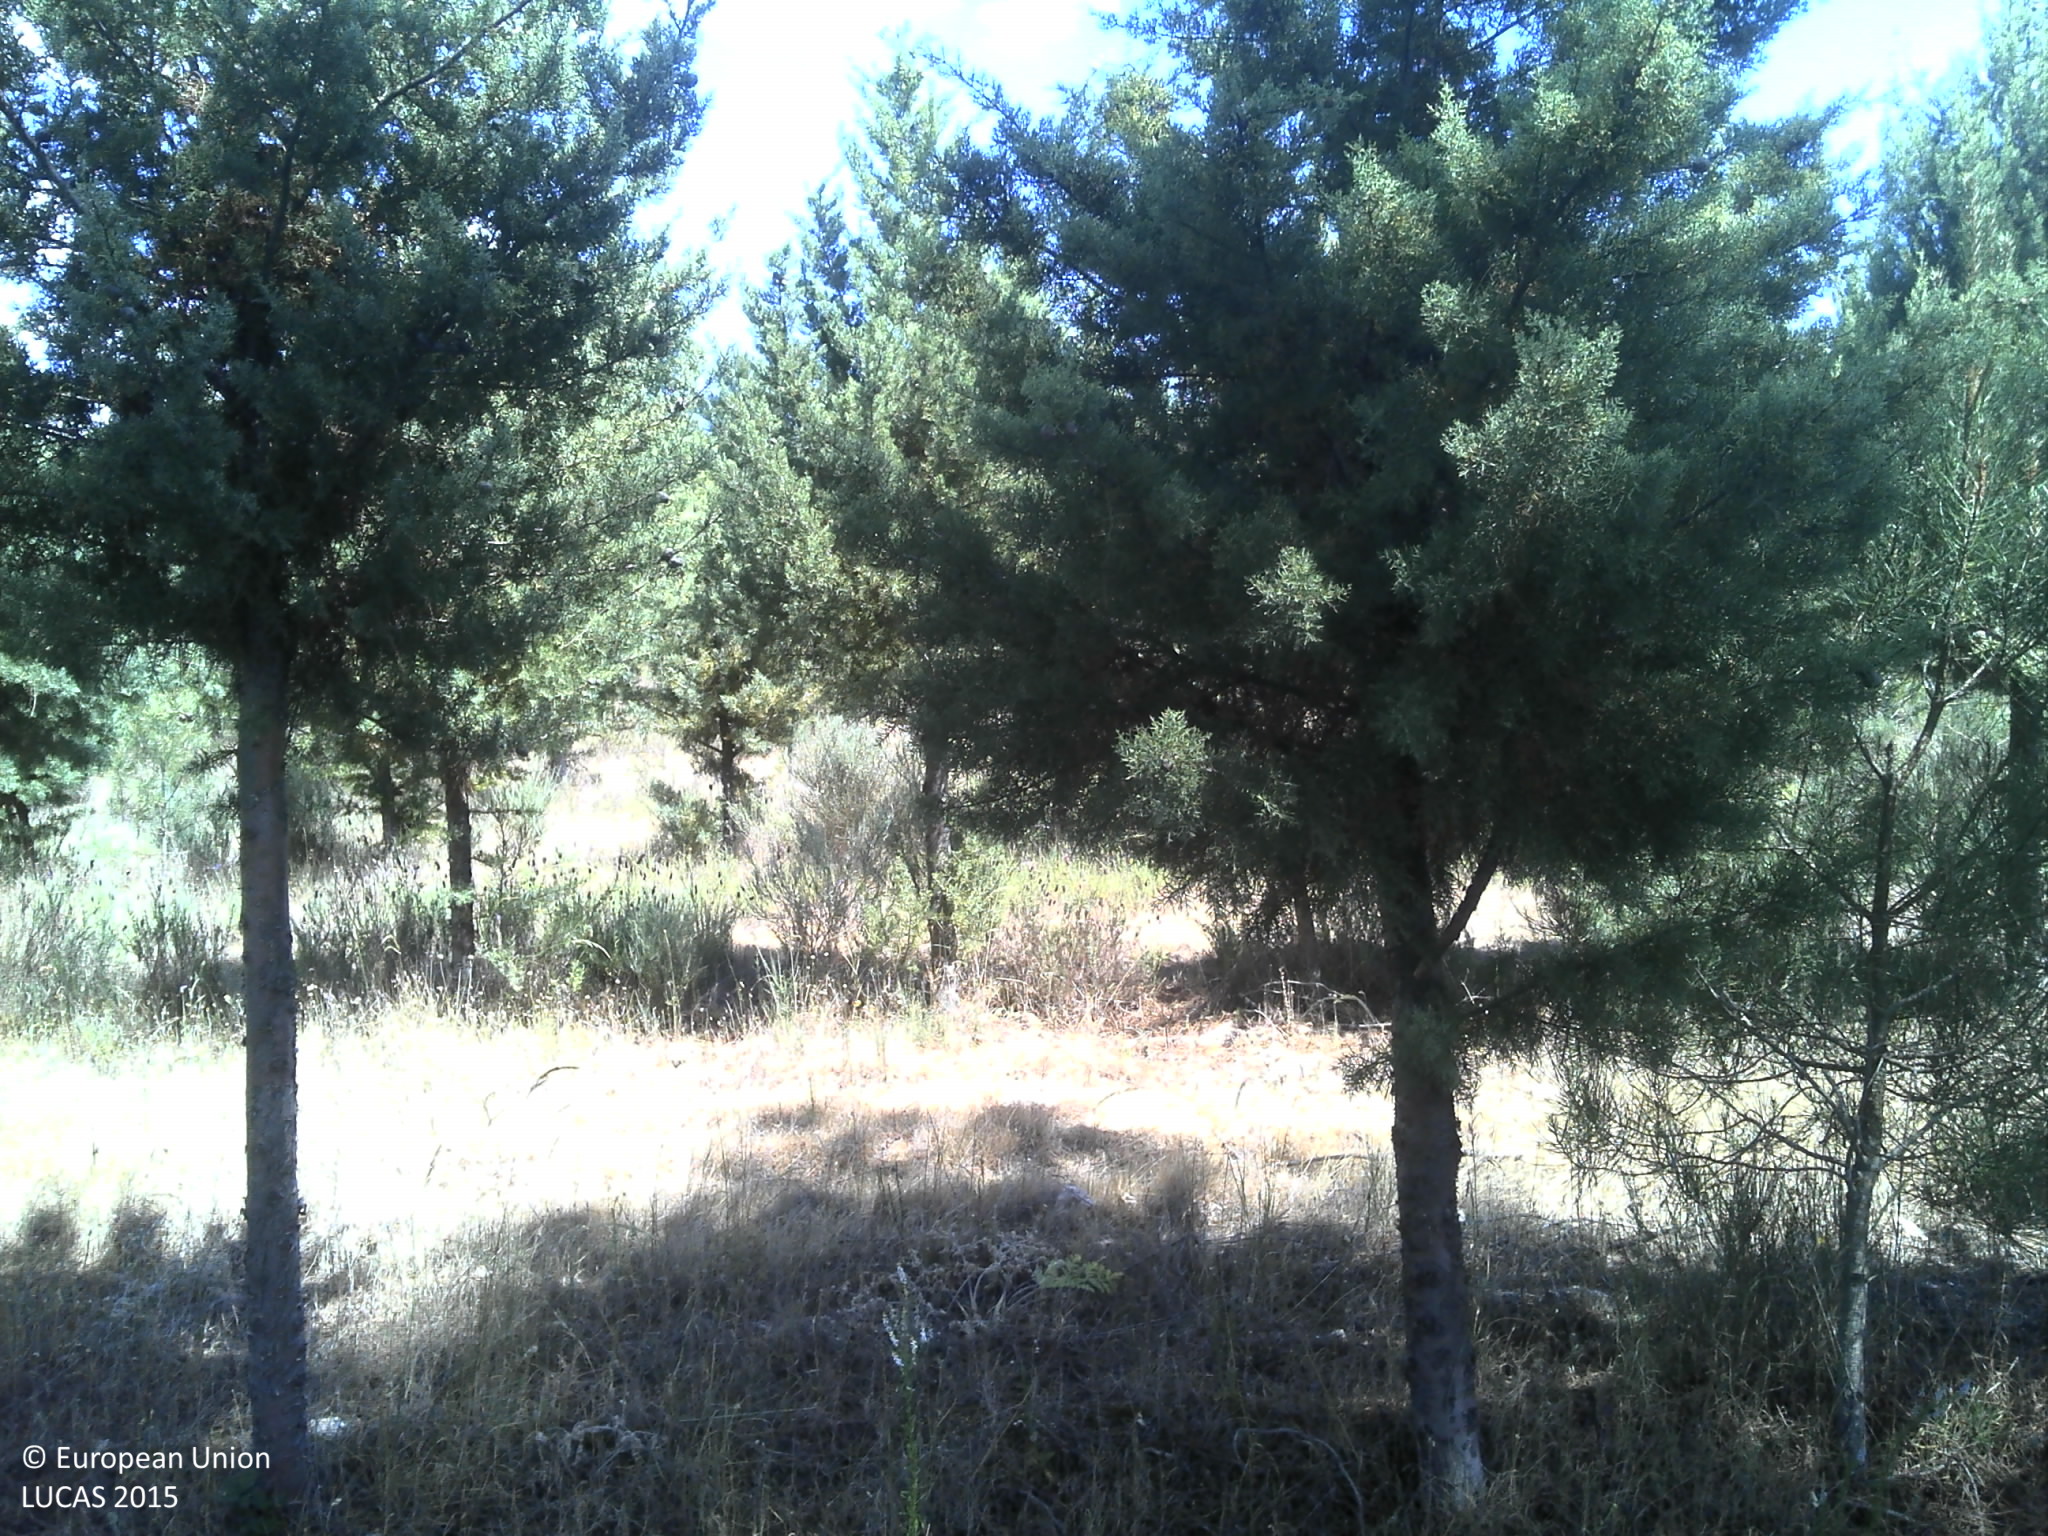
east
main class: Woodland
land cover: Pine dominated coniferous woodland
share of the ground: 50 - 75 %
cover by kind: coniferous forest trees 70 %, unconsolidated bare surface 20 %, shrubs 5 %, herbaceous plants 5 %
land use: Forestry
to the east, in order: Pine dominated coniferous woodland; Other coniferous woodland; Broadleaved woodland; Ditches and canals; Tracks; Ditches and canals; Abandoned hedges; Spontaneously vegetated surfaces
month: June
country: PT
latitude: 40.7109
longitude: -6.8722
